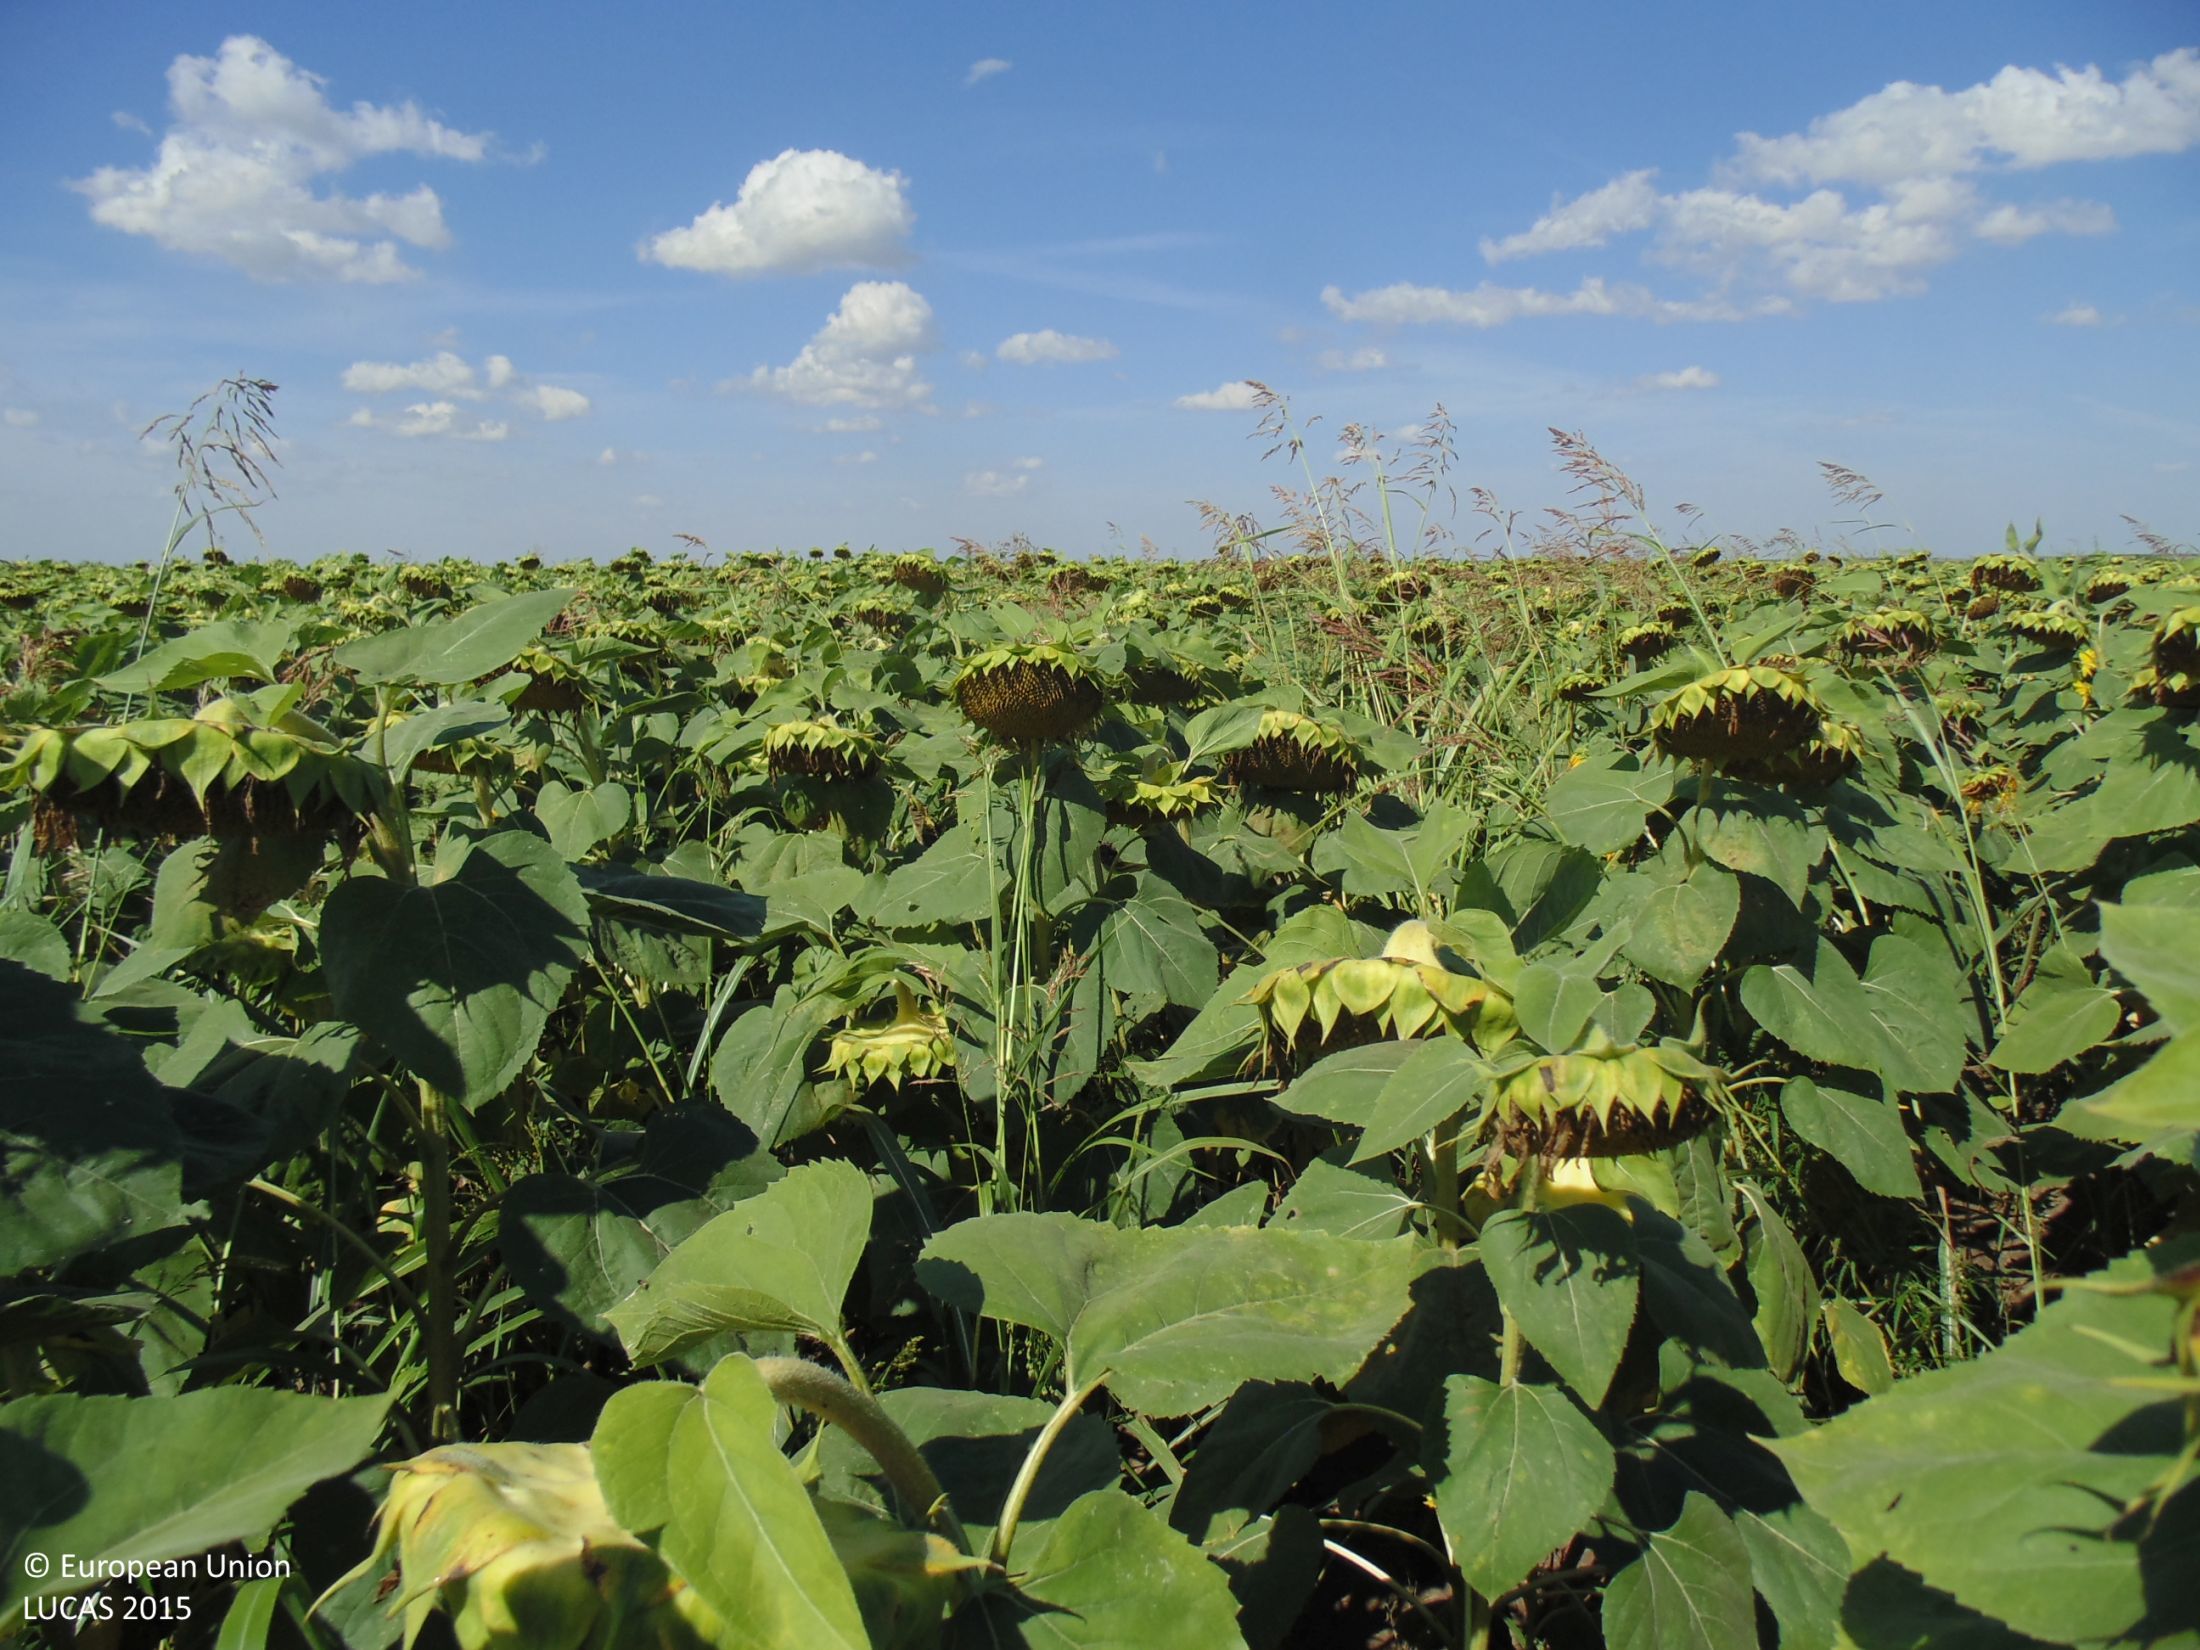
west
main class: Cropland
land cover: Sunflower
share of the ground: > 75 %
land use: Agriculture (excluding fallow land and kitchen gardens)
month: August
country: BG
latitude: 43.7437
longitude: 27.8645
